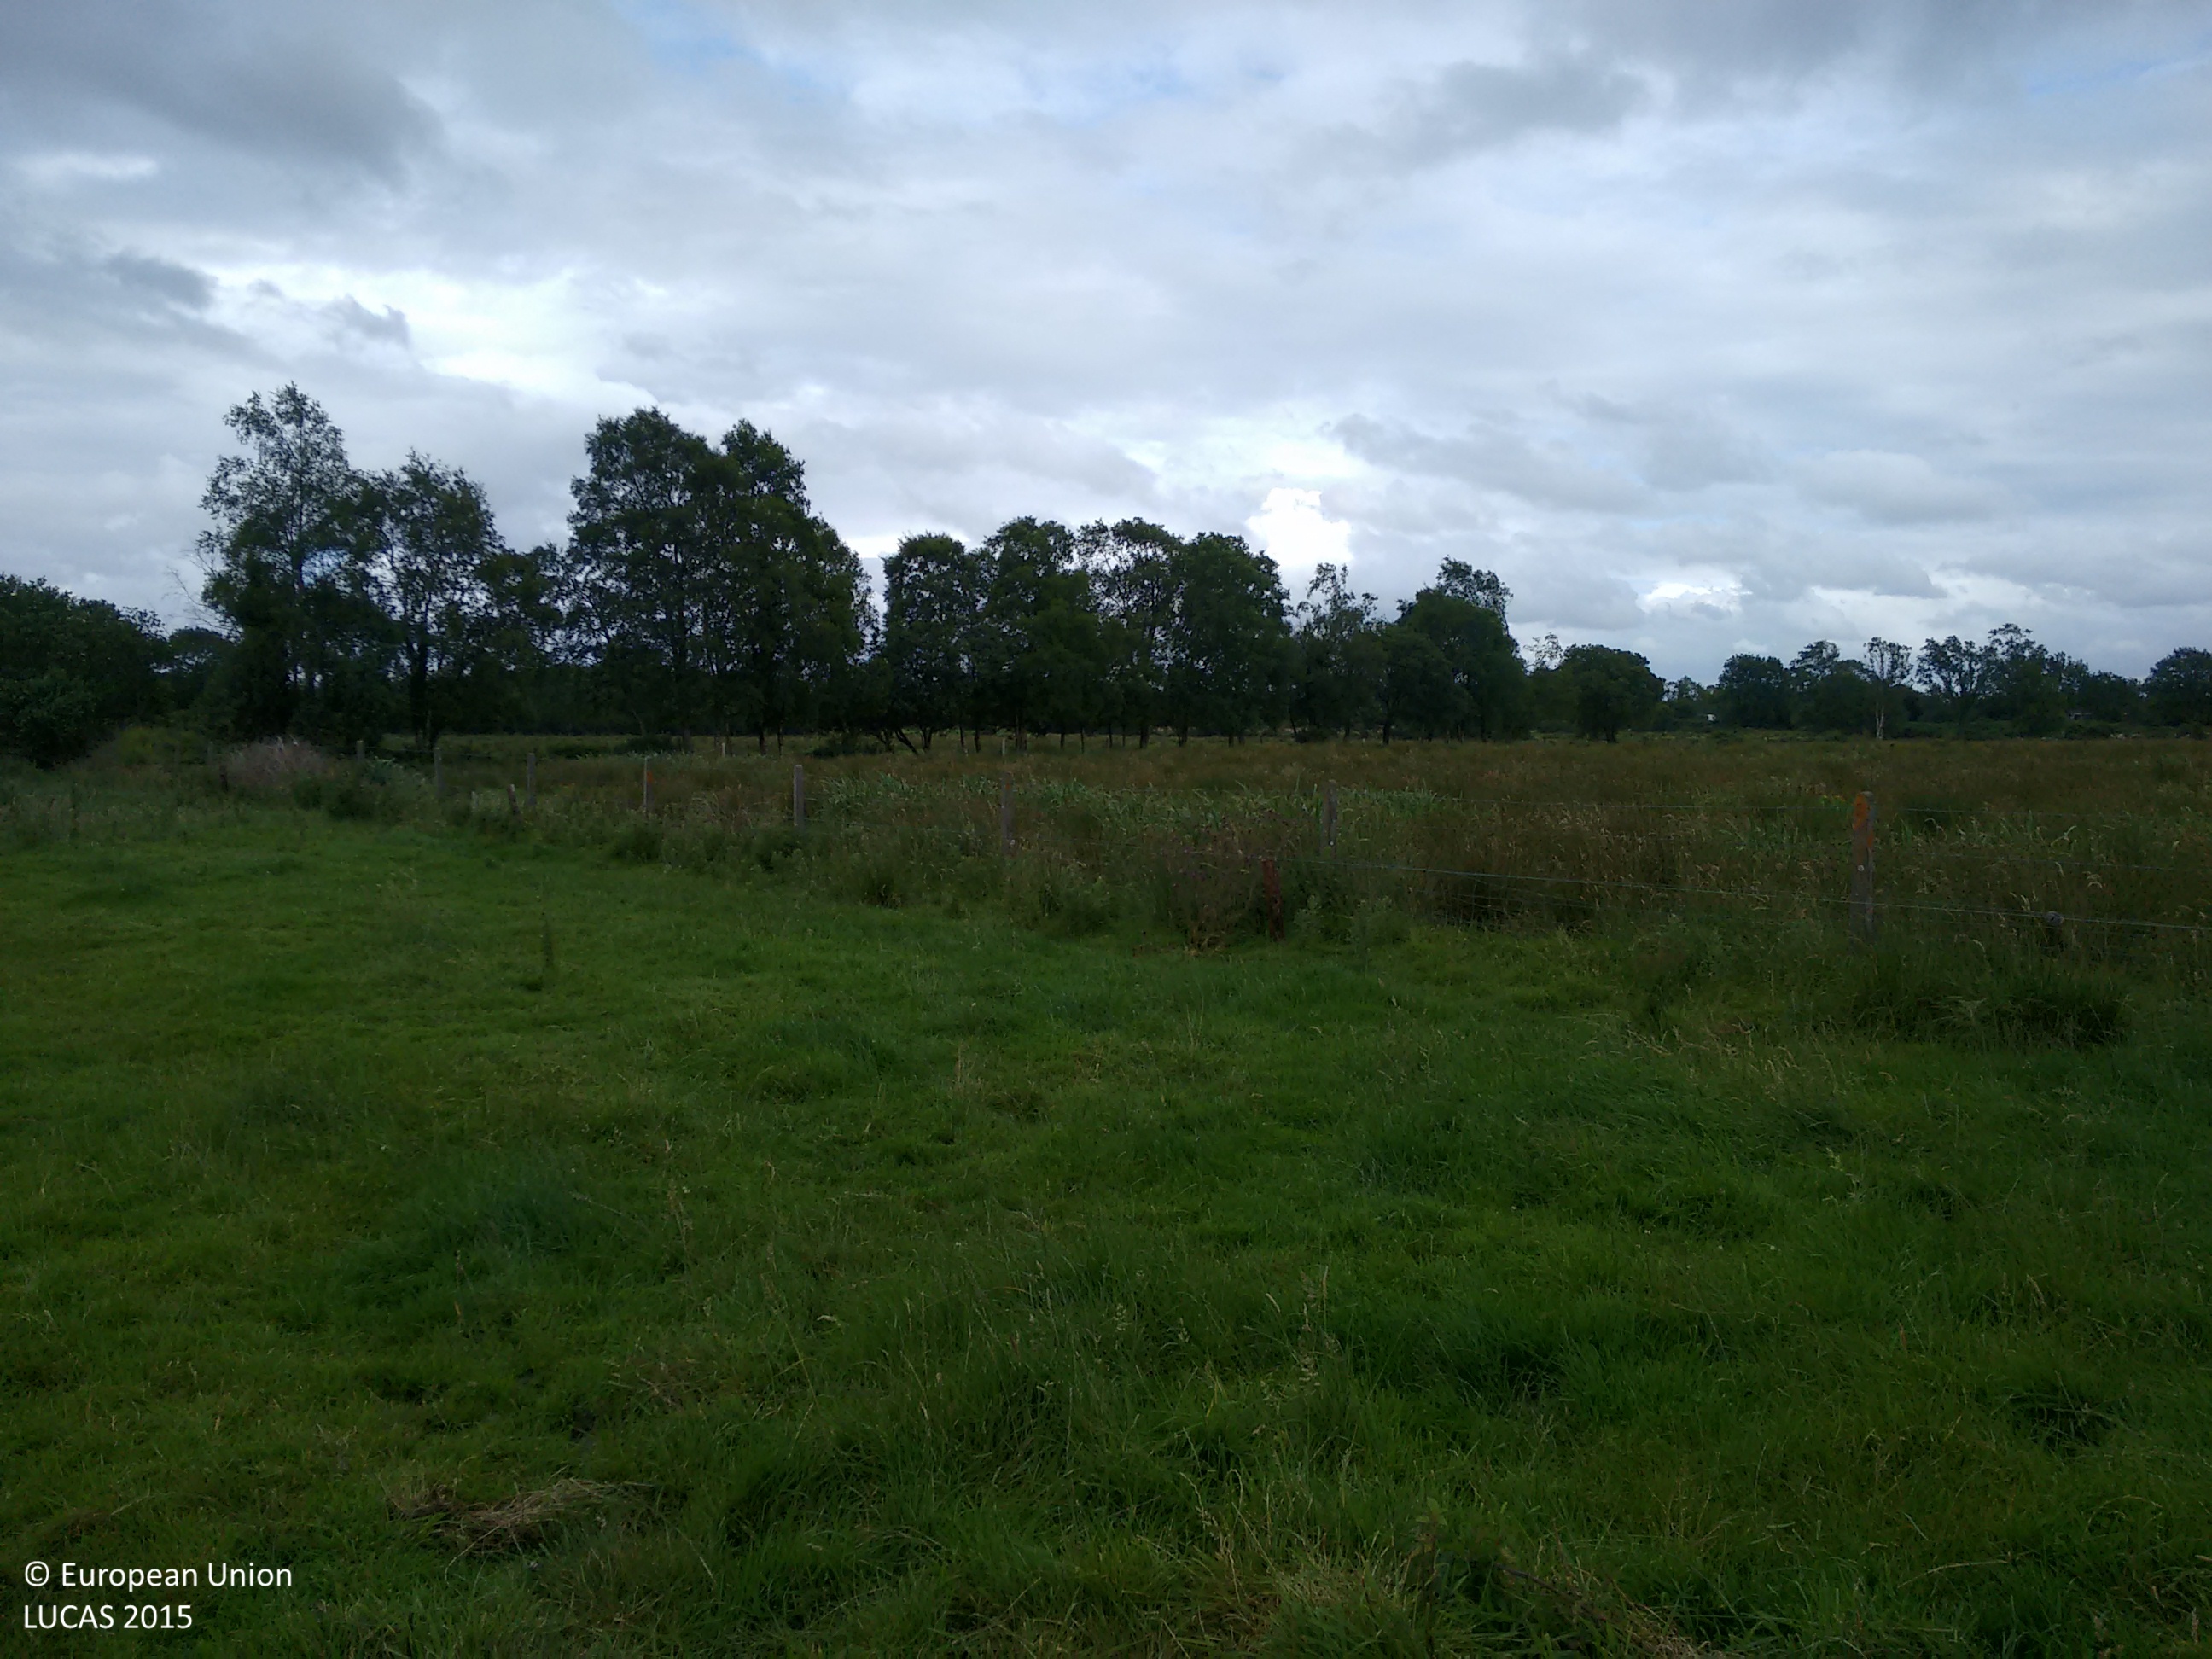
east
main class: Grassland
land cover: Grassland without tree/shrub cover
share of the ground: > 75 %
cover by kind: herbaceous plants 100 %
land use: Agriculture (excluding fallow land and kitchen gardens)
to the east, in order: Grassland without tree/shrub cover; Fences; Grassland without tree/shrub cover; Lines of trees; Ditches and canals; Grassland without tree/shrub cover
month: July
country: IE
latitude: 53.6325
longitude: -7.8167
